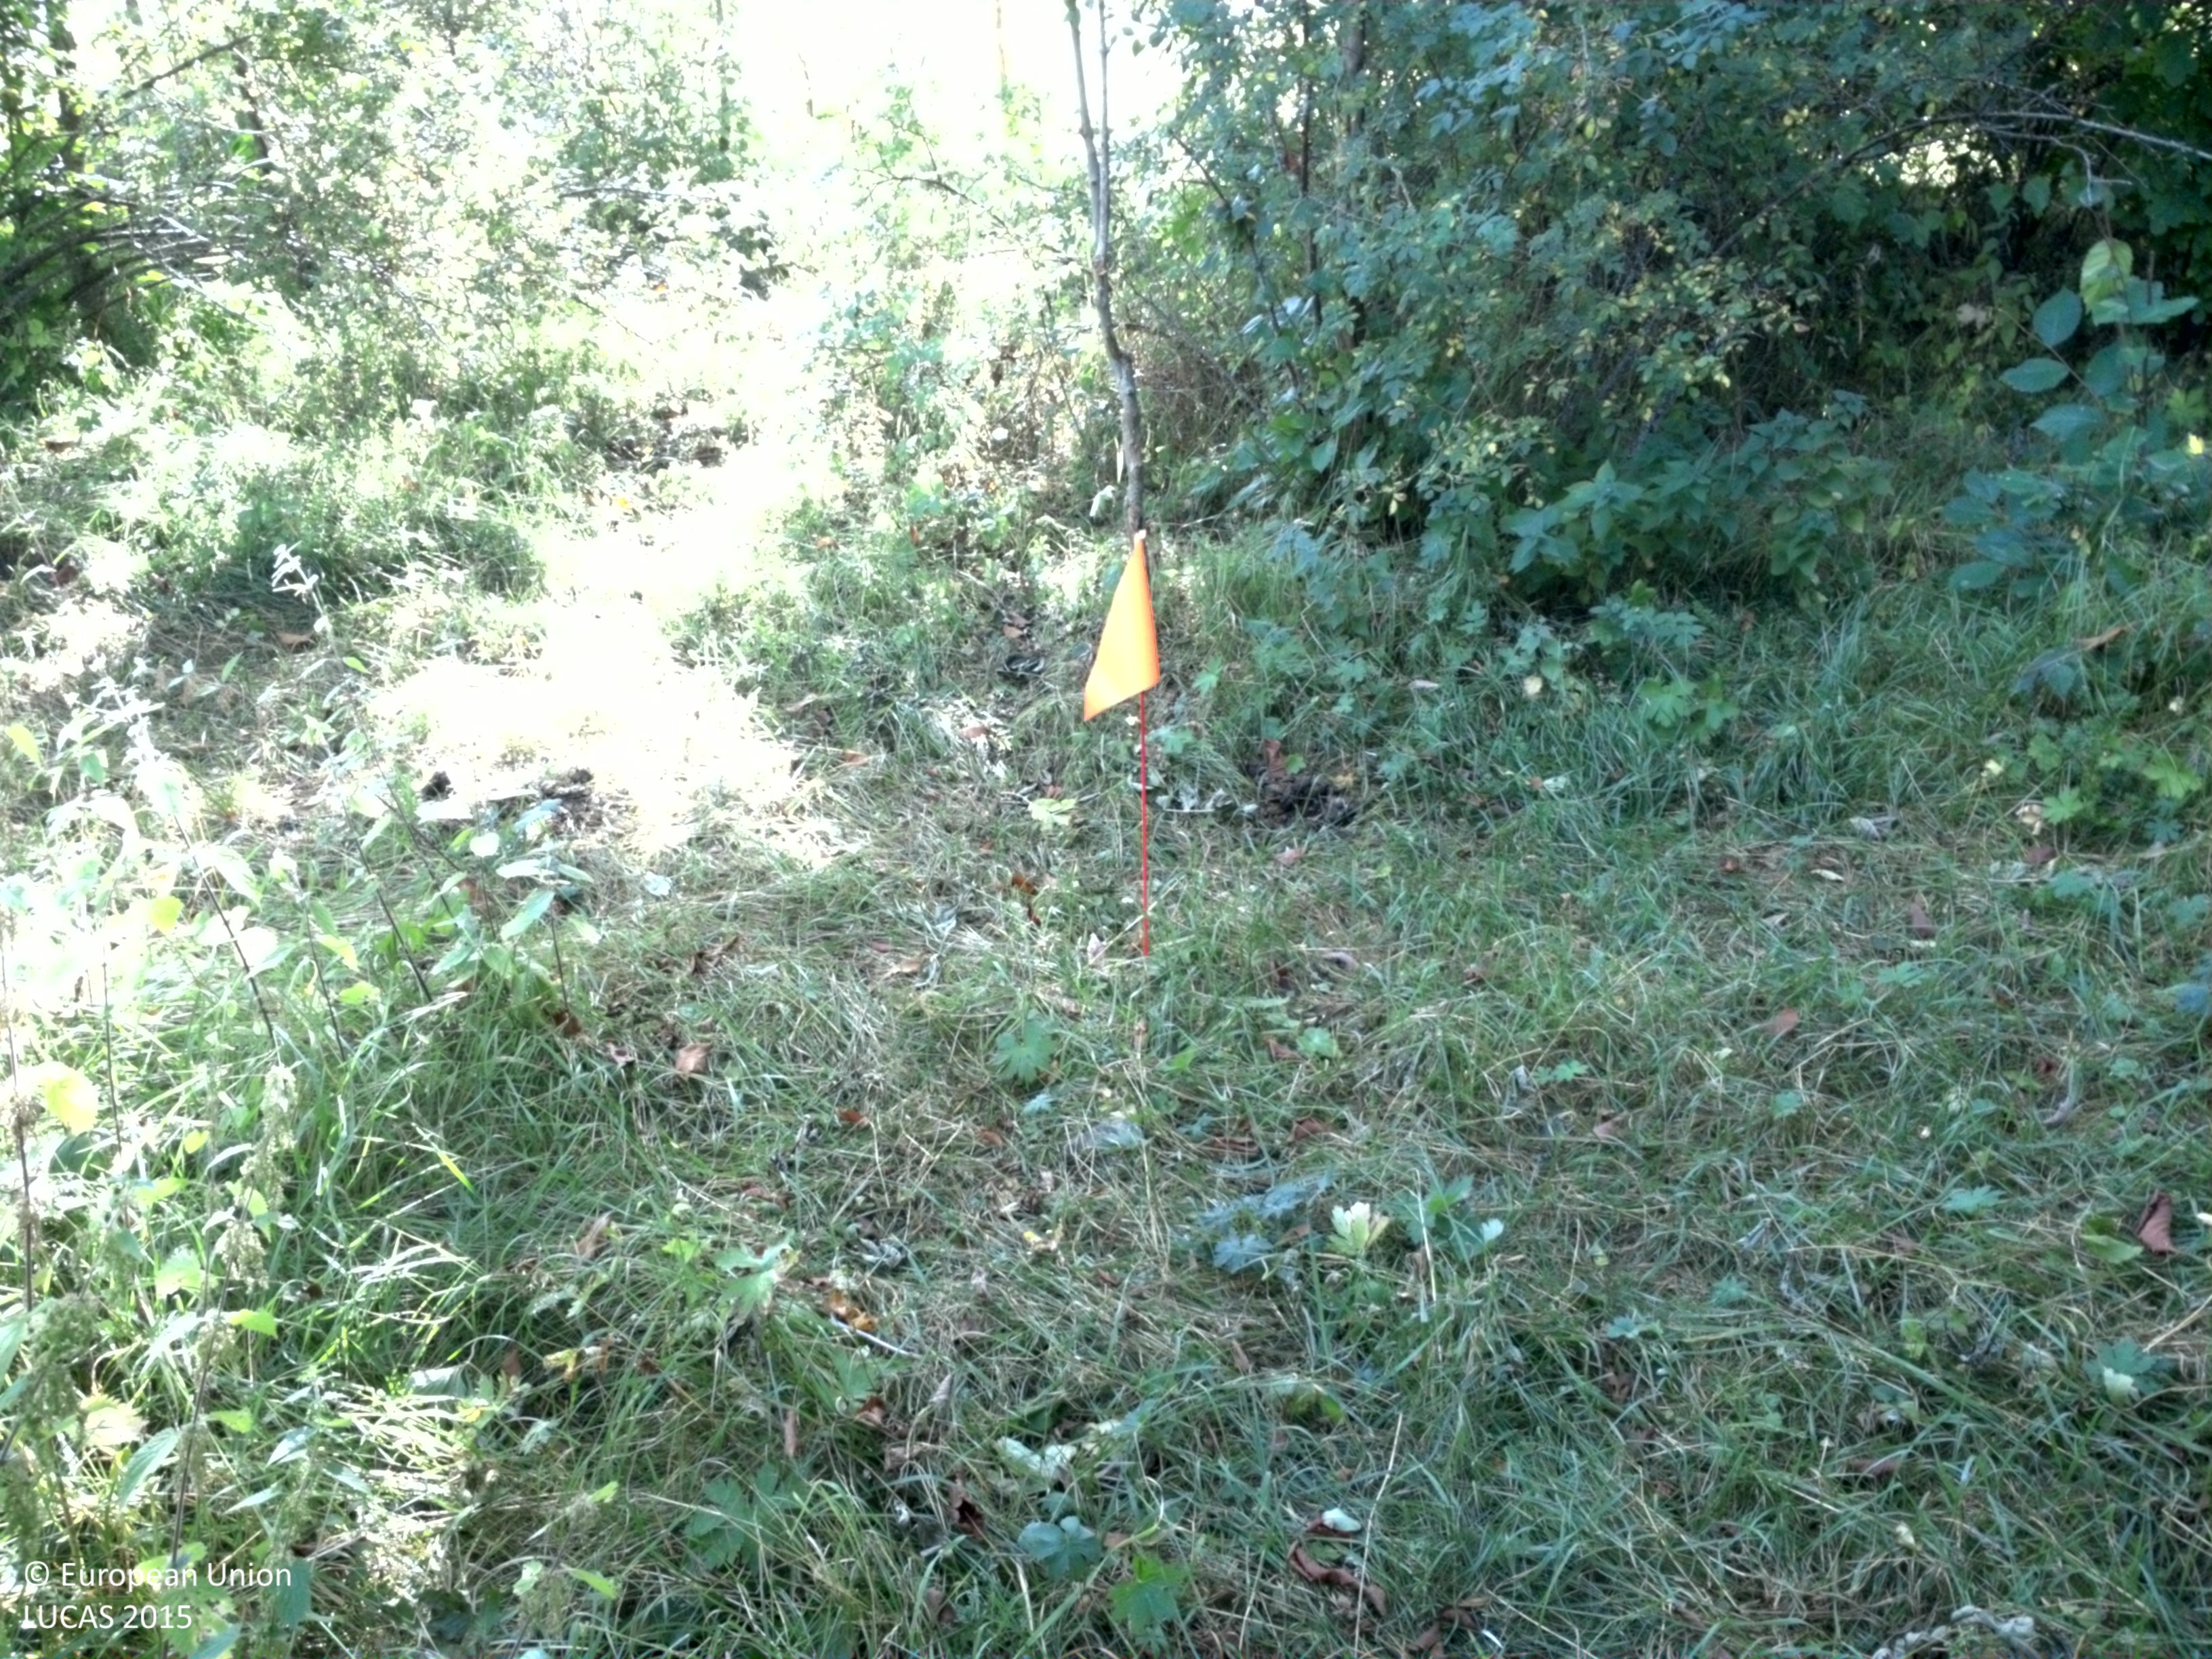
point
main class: Woodland
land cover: Broadleaved woodland
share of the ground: > 75 %
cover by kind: broadleaved forest trees 75 %, herbaceous plants 25 %
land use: Agriculture (excluding fallow land and kitchen gardens)
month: August
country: SE
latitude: 59.5940
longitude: 17.6301
